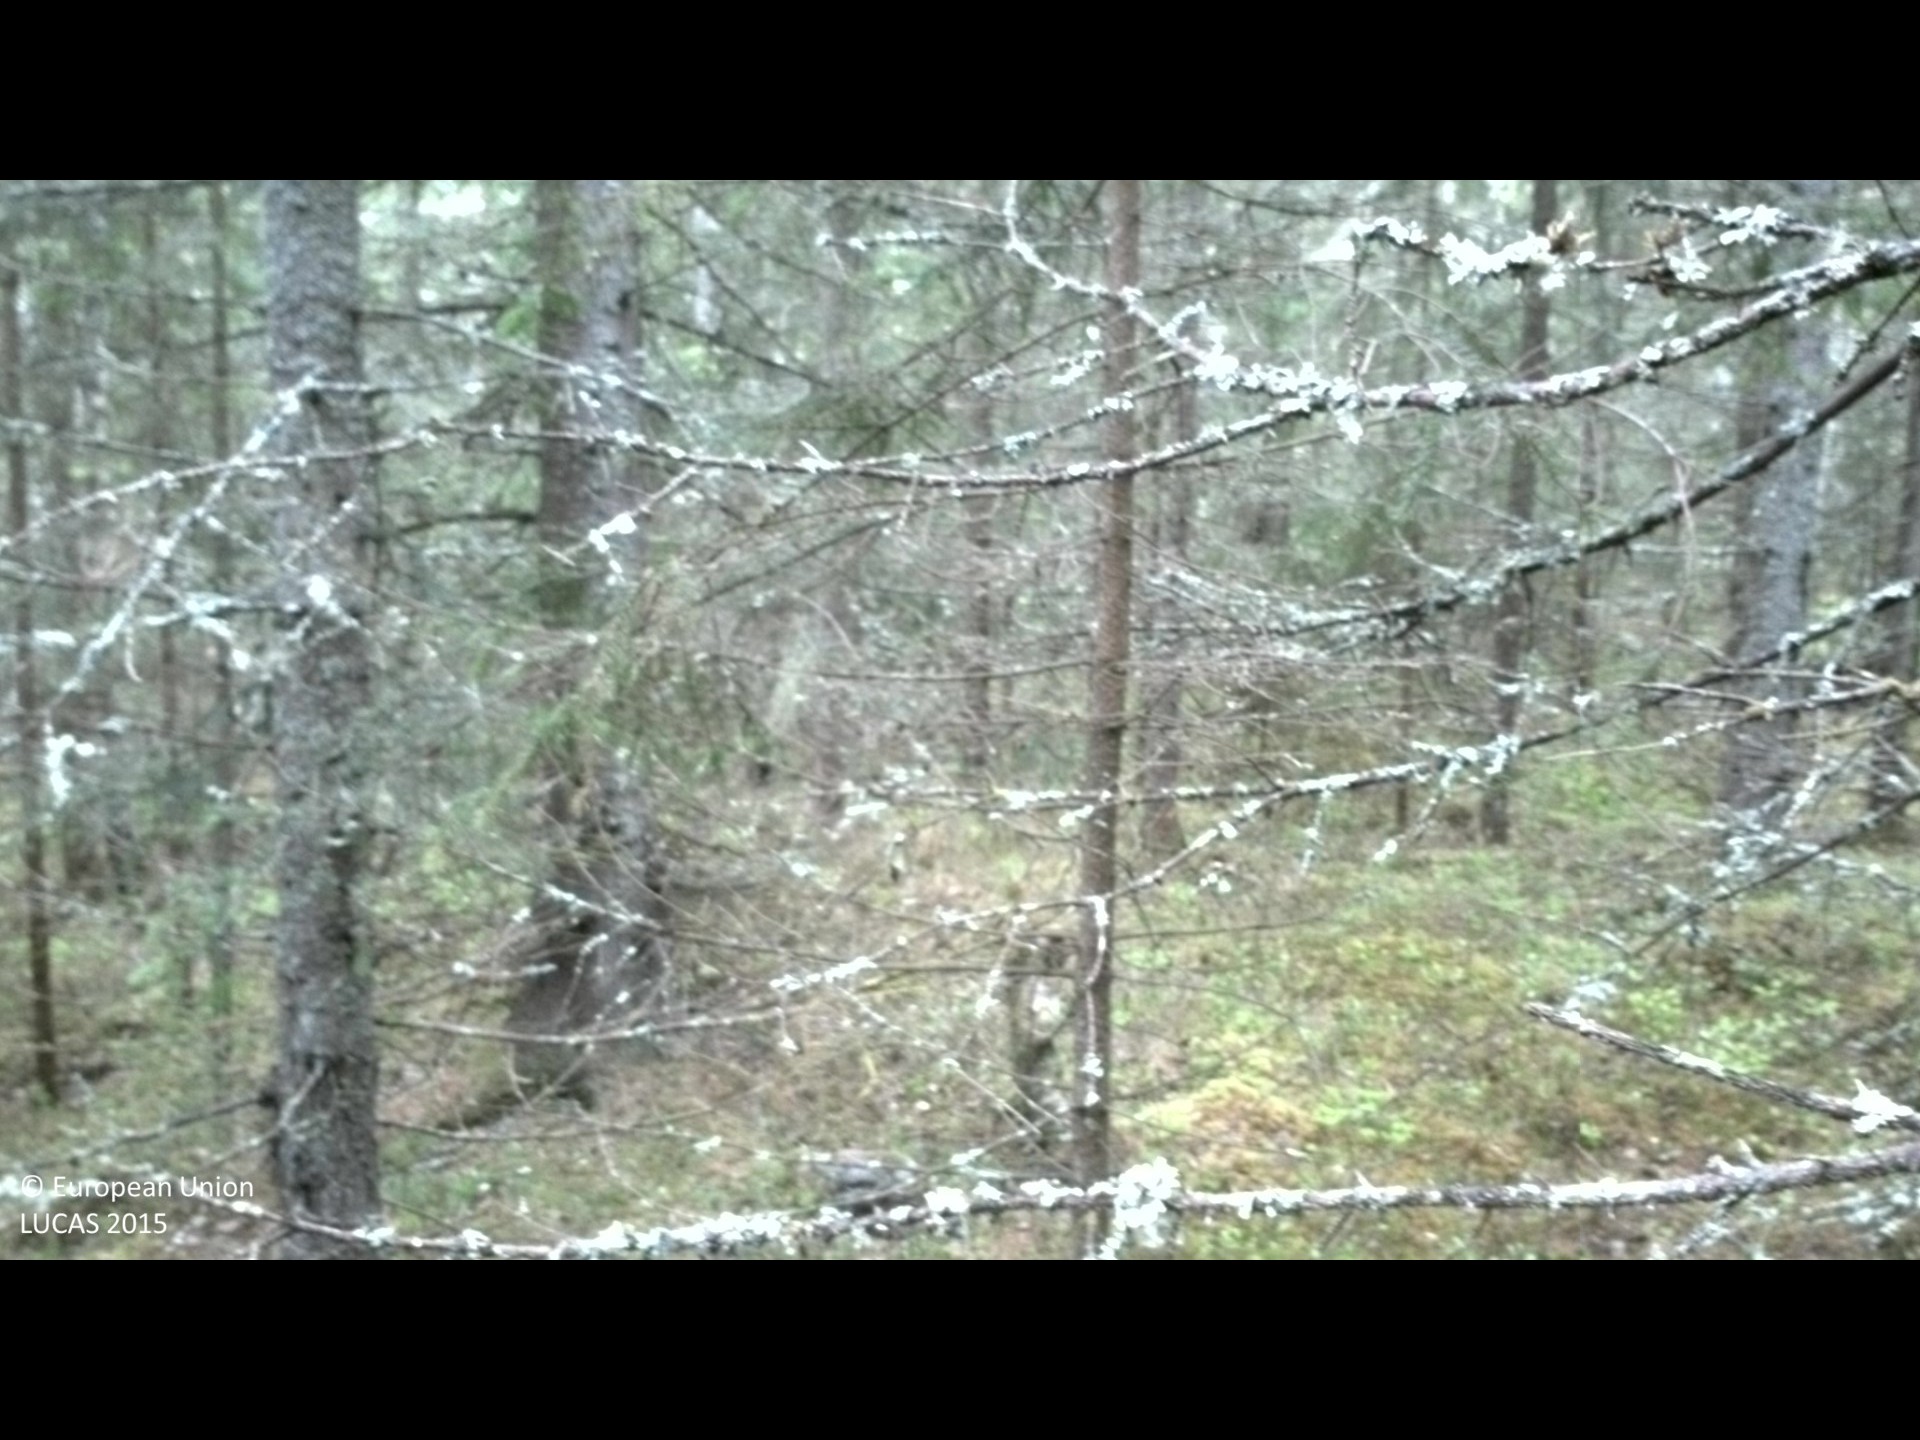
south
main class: Woodland
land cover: Spruce dominated mixed woodland
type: boreal forest
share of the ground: > 75 %
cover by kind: coniferous forest trees 60 %, broadleaved forest trees 20 %, shrubs 20 %
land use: Forestry
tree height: > 5 m
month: May
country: SE
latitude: 62.9777
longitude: 17.6915
